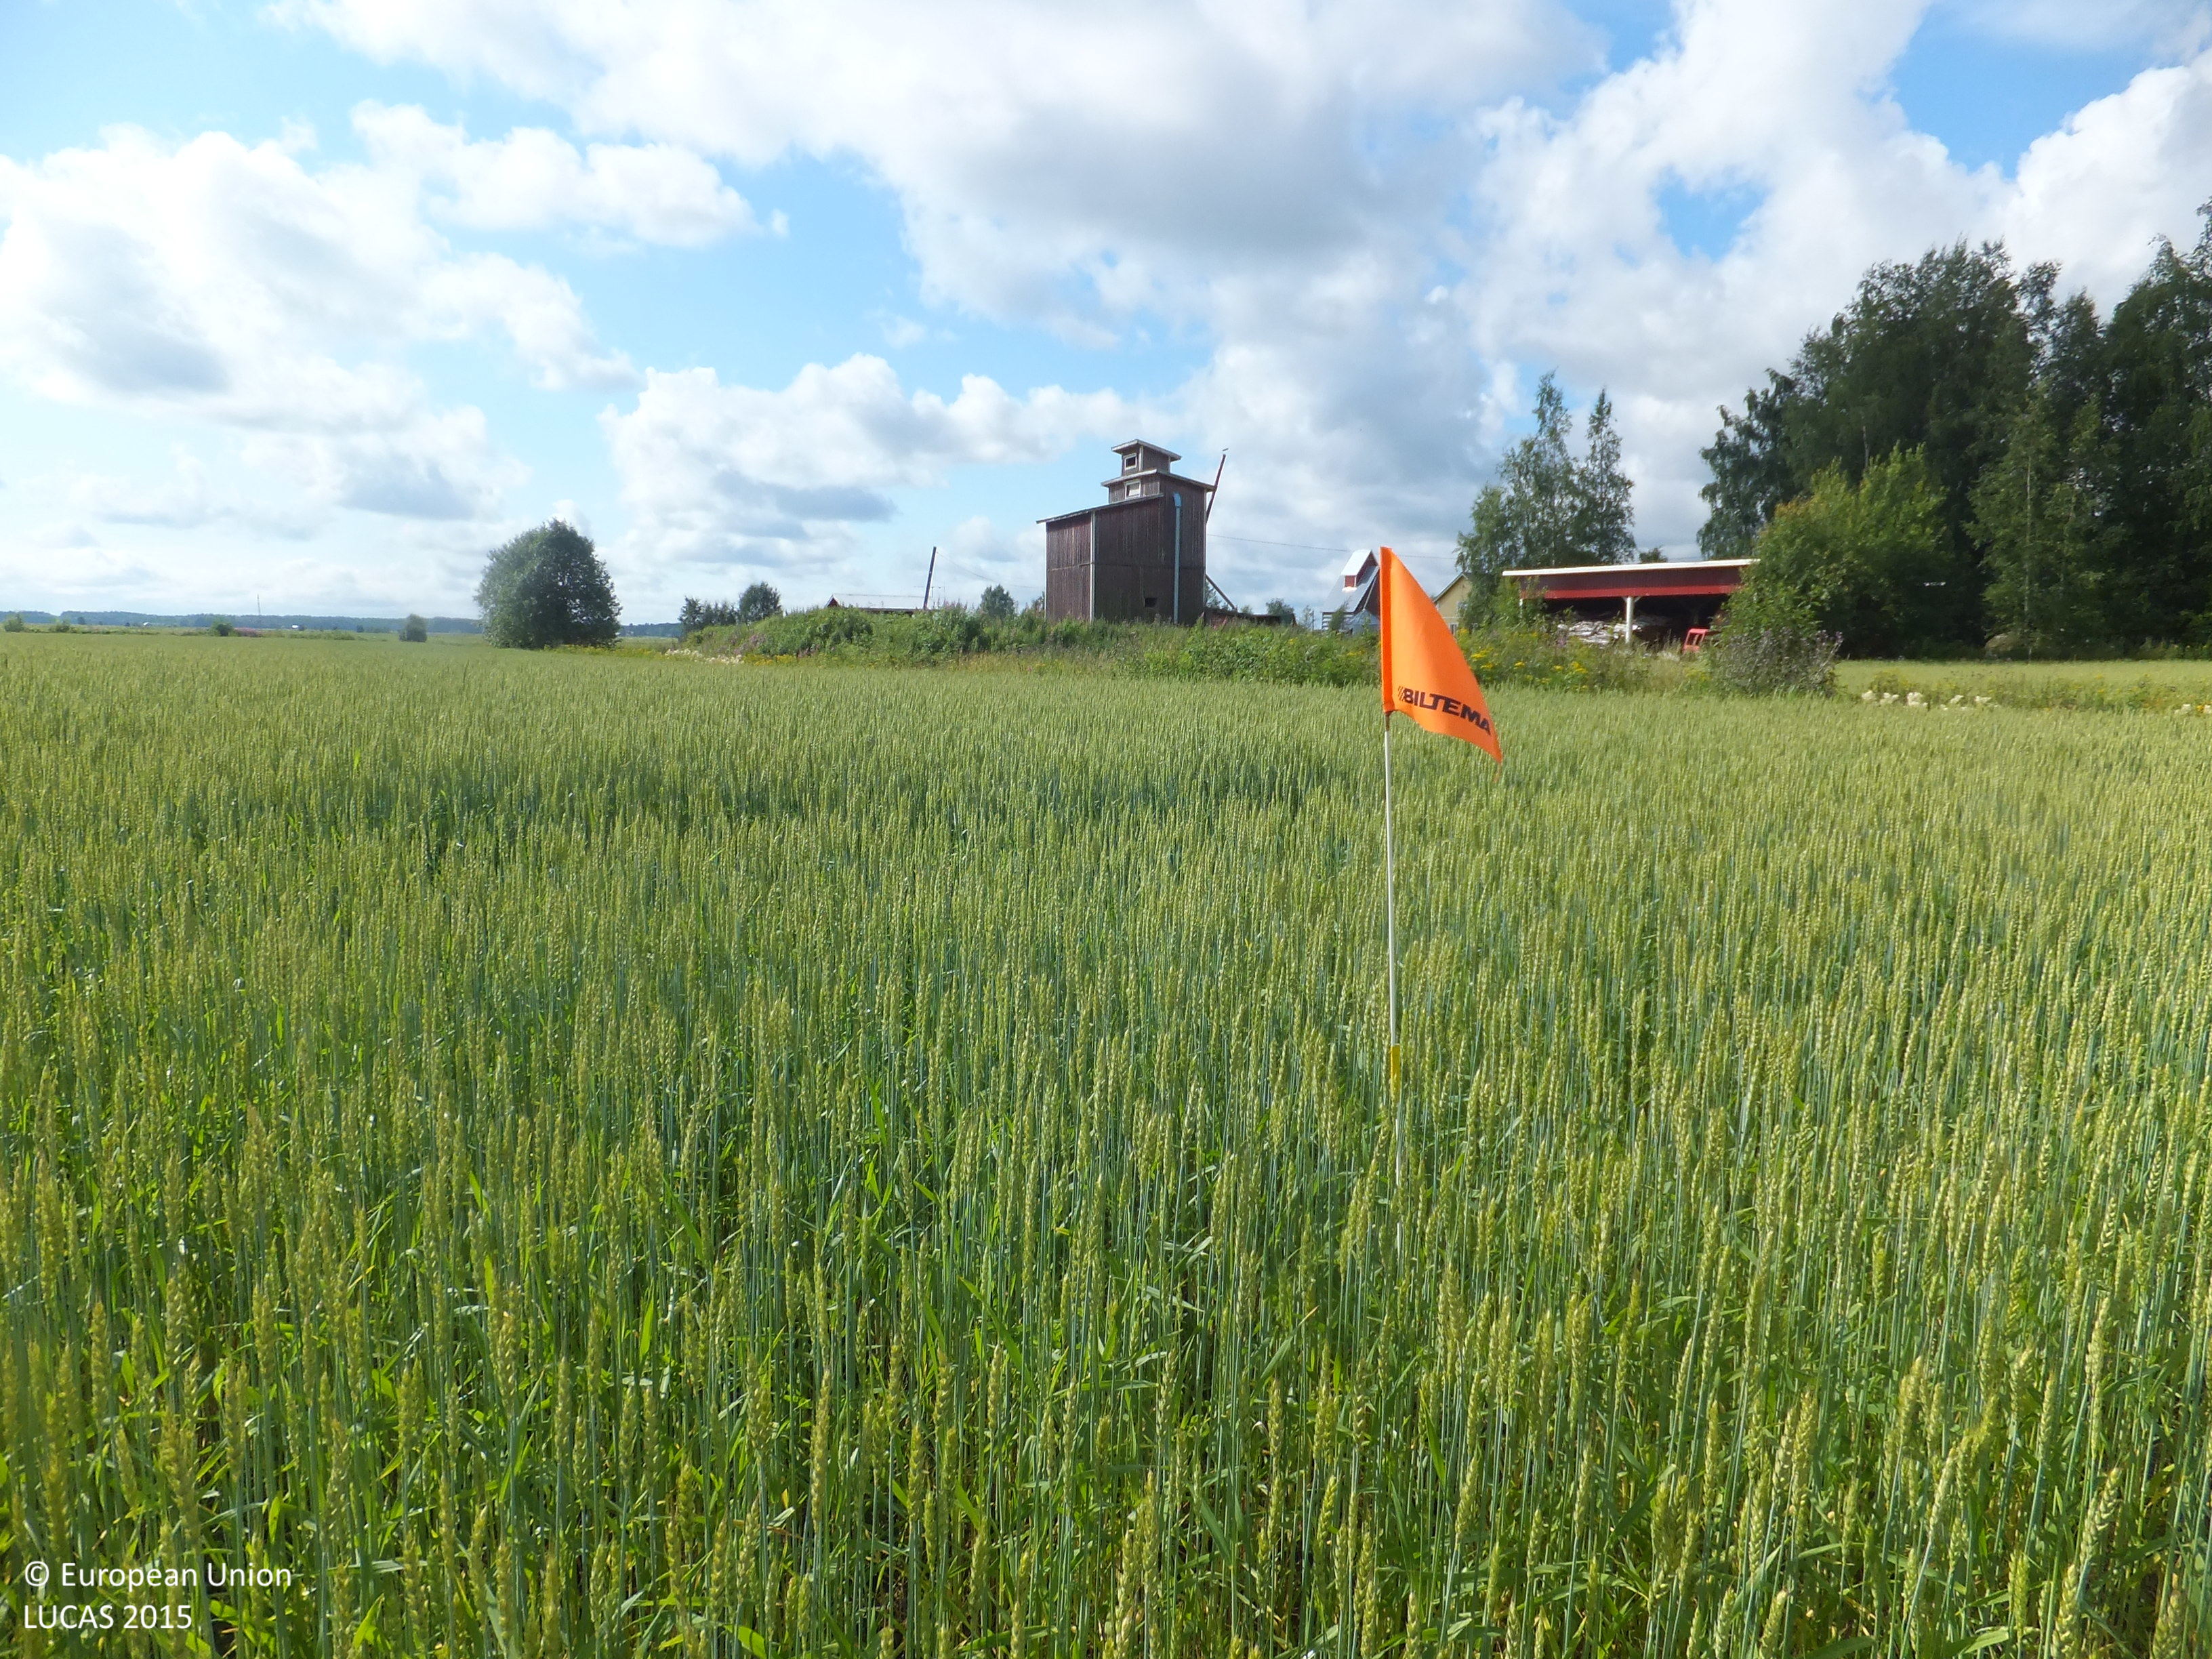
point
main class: Cropland
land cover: Common wheat
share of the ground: > 75 %
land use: Agriculture (excluding fallow land and kitchen gardens)
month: July
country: FI
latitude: 63.0702
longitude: 22.1387
